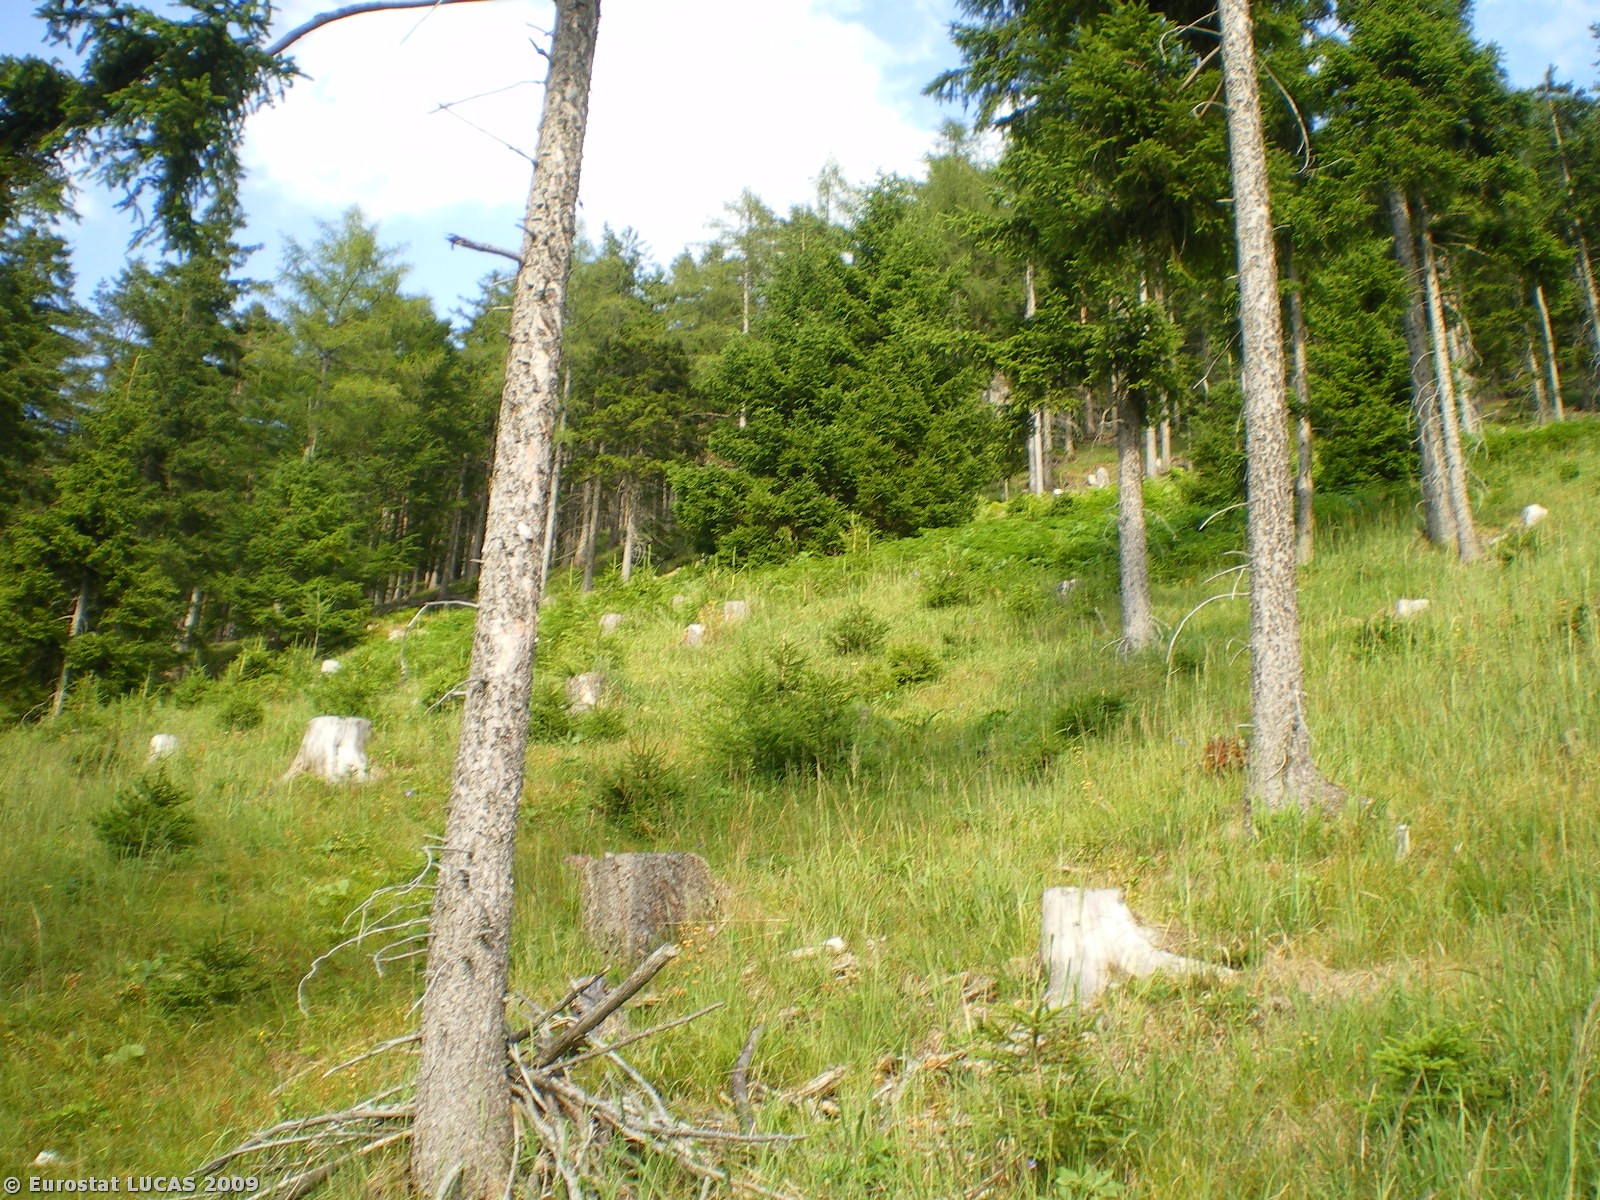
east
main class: Woodland
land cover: Coniferous woodland
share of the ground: 25 - 50 %
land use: Forestry
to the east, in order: Coniferous woodland; Grassland with sparse tree/shrub cover; Grass margins; Tracks; Groves; Coniferous woodland; Tracks; Coniferous woodland; Tracks
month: July
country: AT
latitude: 47.8549
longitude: 15.7896
